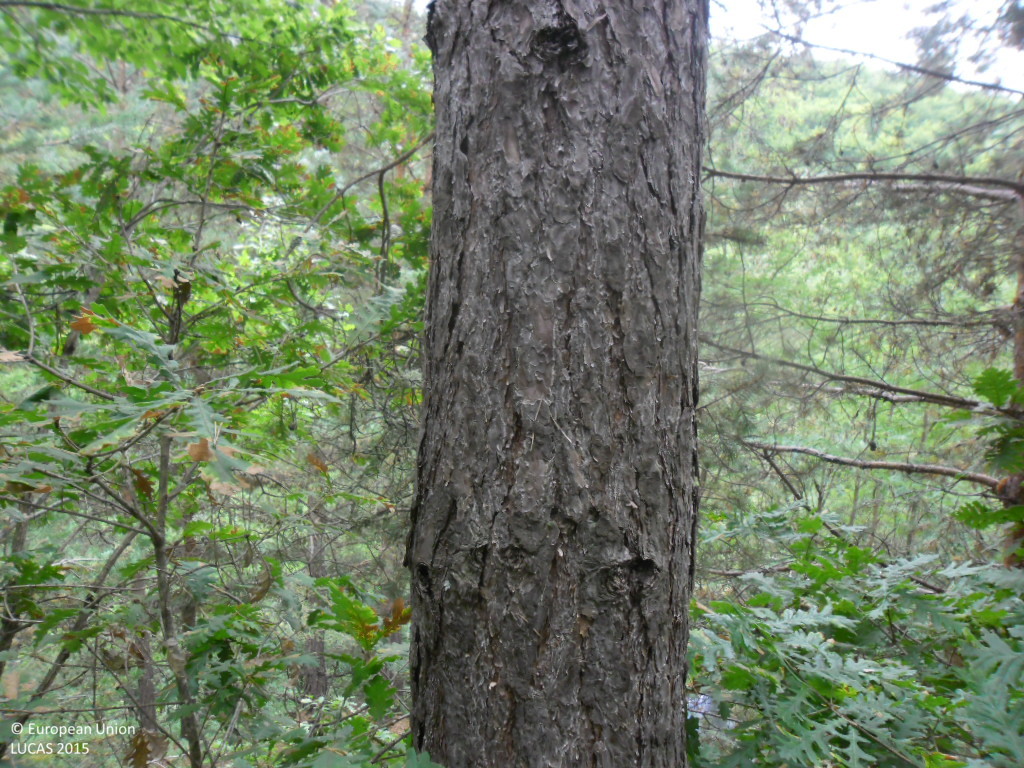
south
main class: Woodland
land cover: Pine dominated coniferous woodland
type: hemiboreal forest and nemoral coniferous forest and mixed broadleaved-coniferous forest
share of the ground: > 75 %
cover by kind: coniferous forest trees 95 %, unconsolidated bare surface 5 %
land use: Forestry
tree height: > 5 m
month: September
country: BG
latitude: 41.6418
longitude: 23.0458
